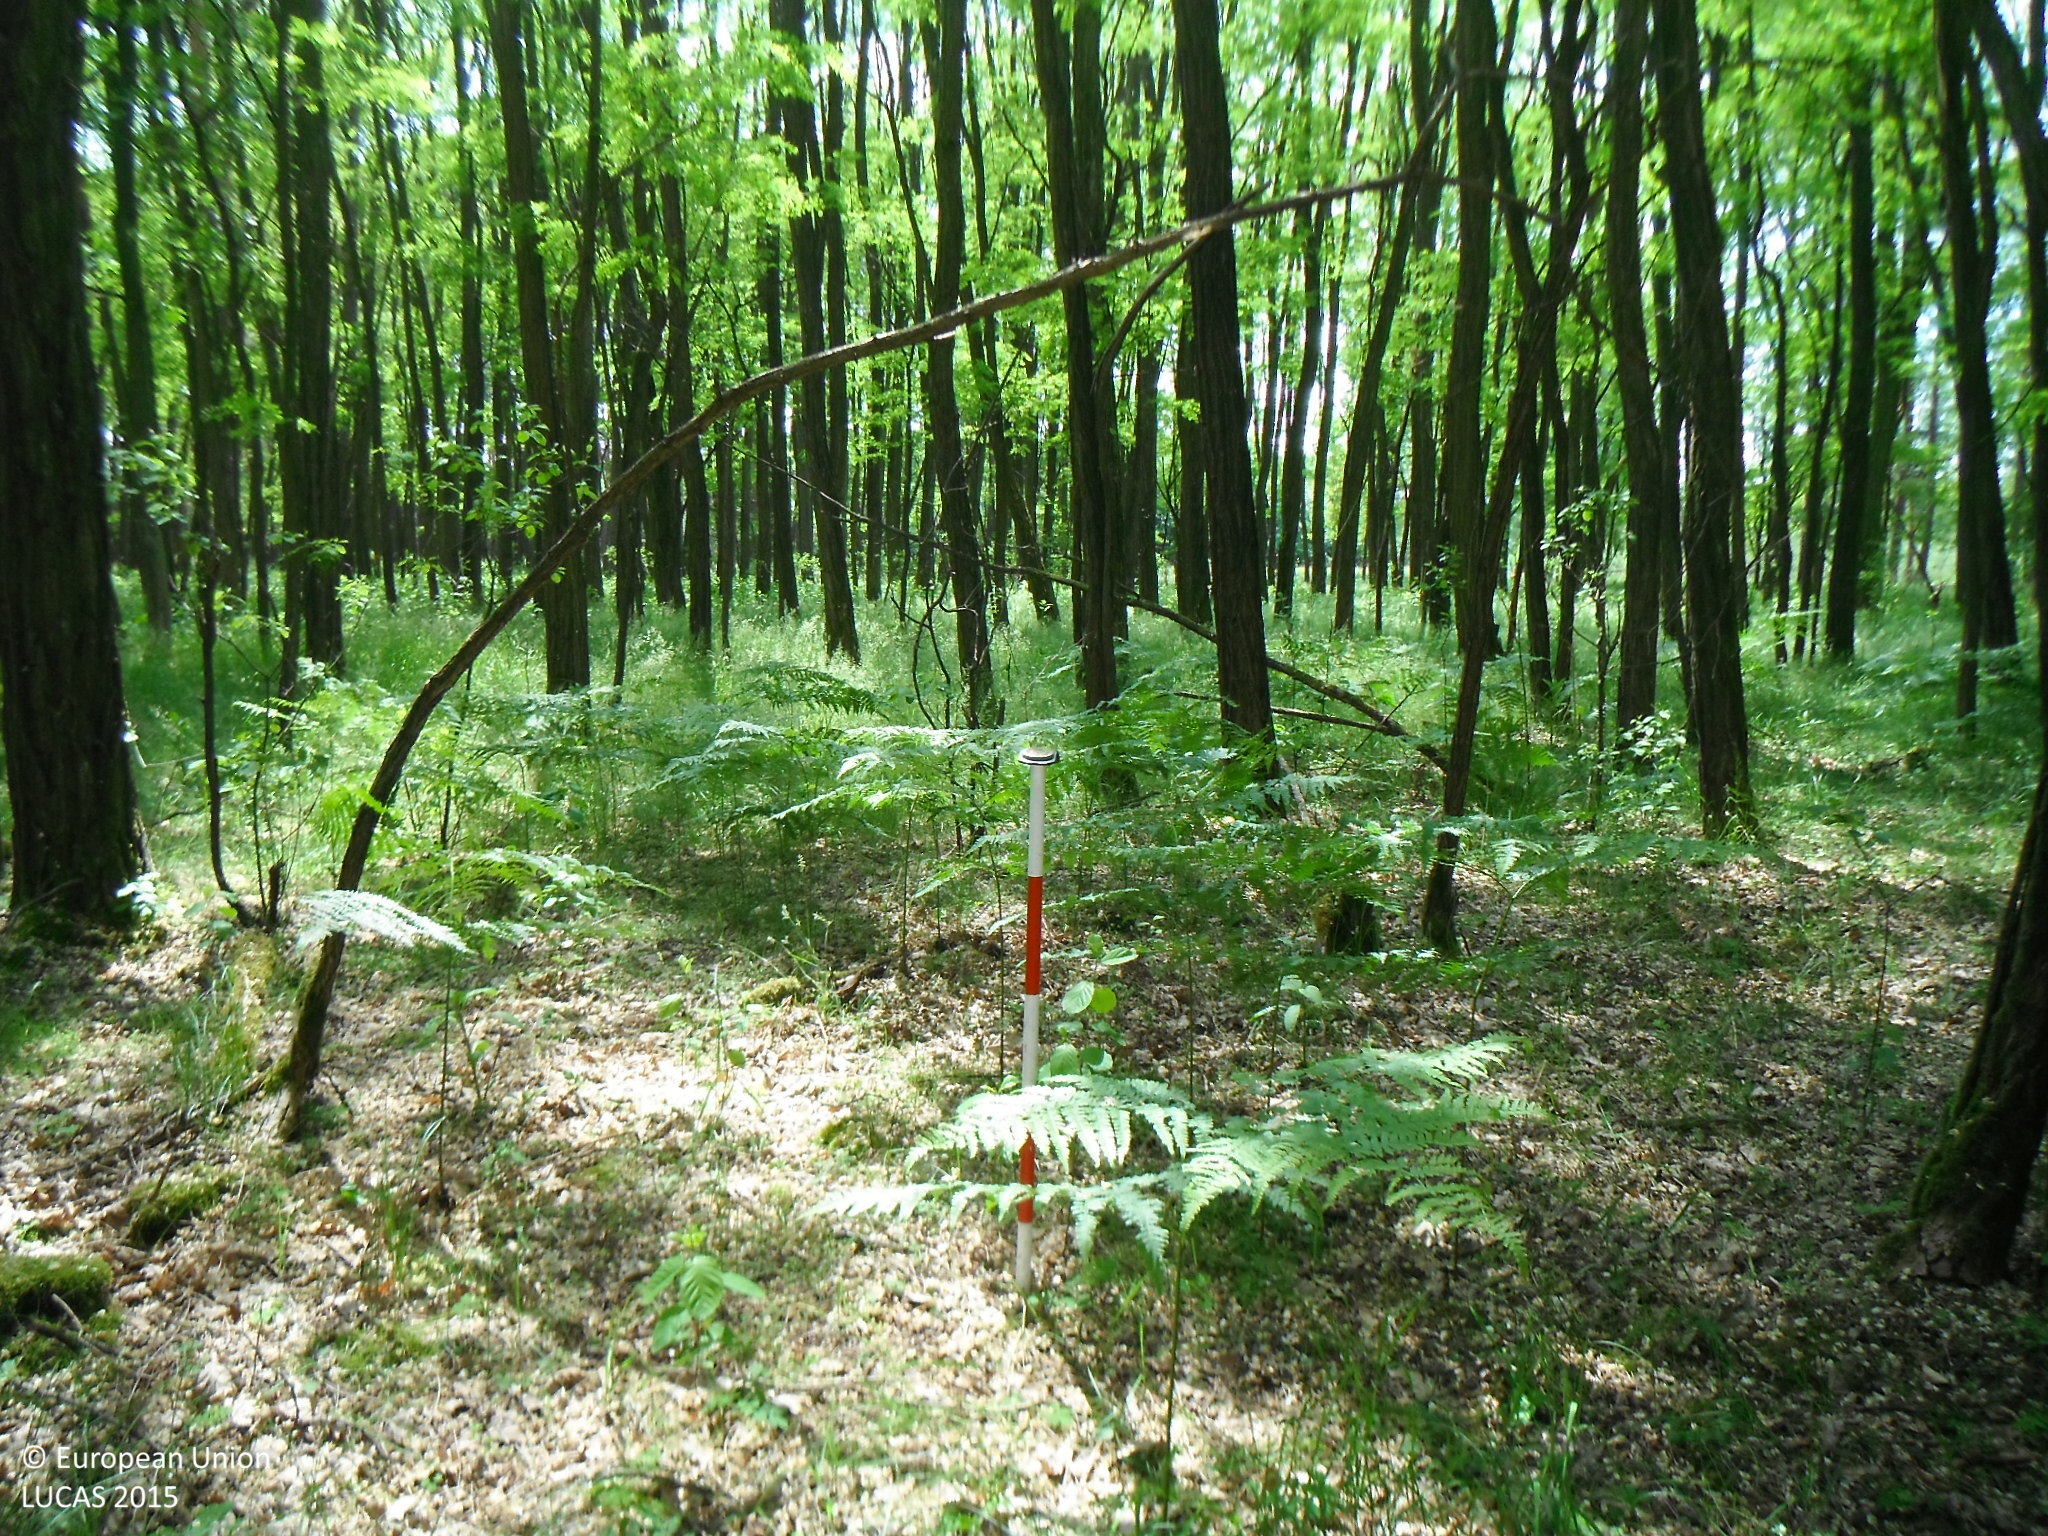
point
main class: Woodland
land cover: Broadleaved woodland
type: exotic forest
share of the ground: > 75 %
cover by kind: broadleaved forest trees 85 %, shrubs 5 %, herbaceous plants 5 %, unconsolidated bare surface 5 %
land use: Forestry
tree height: > 5 m
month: June
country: SK
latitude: 48.5513
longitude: 17.1484
